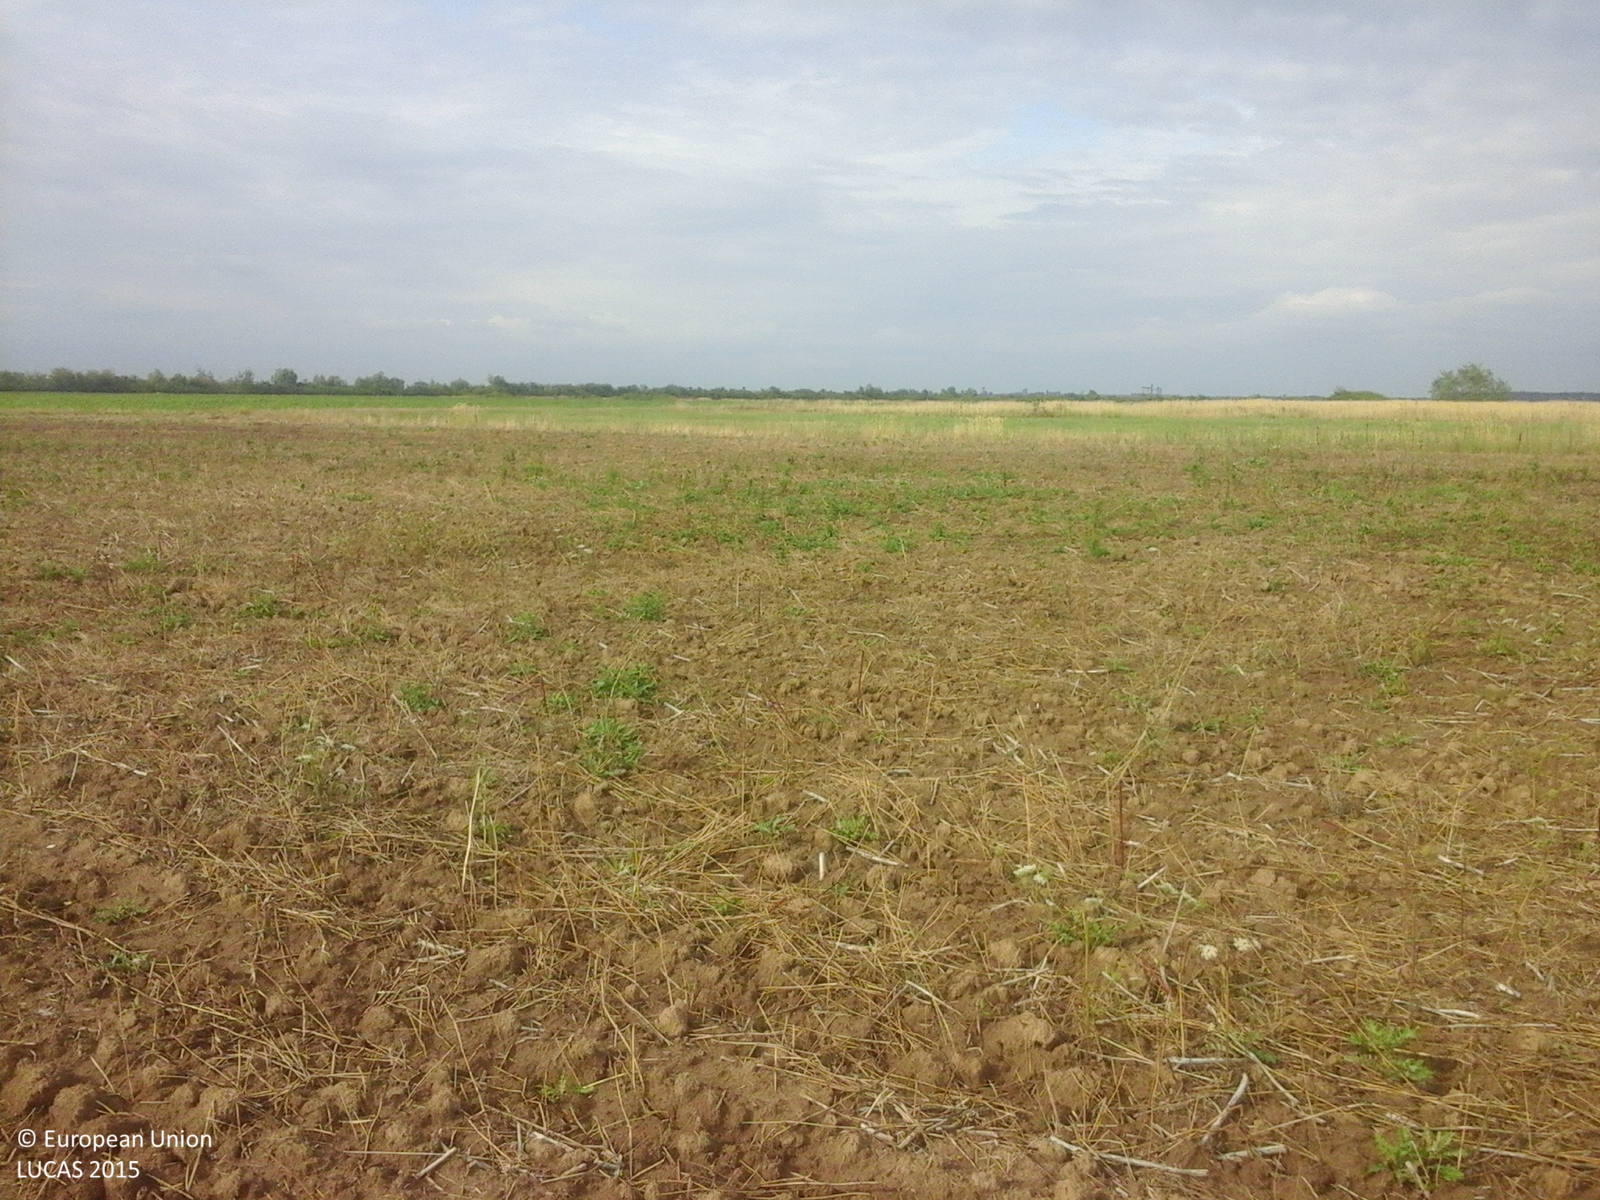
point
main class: Cropland
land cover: Rape and turnip rape
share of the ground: < 10 %
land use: Agriculture (excluding fallow land and kitchen gardens)
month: August
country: RO
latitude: 45.3887
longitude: 21.2816
